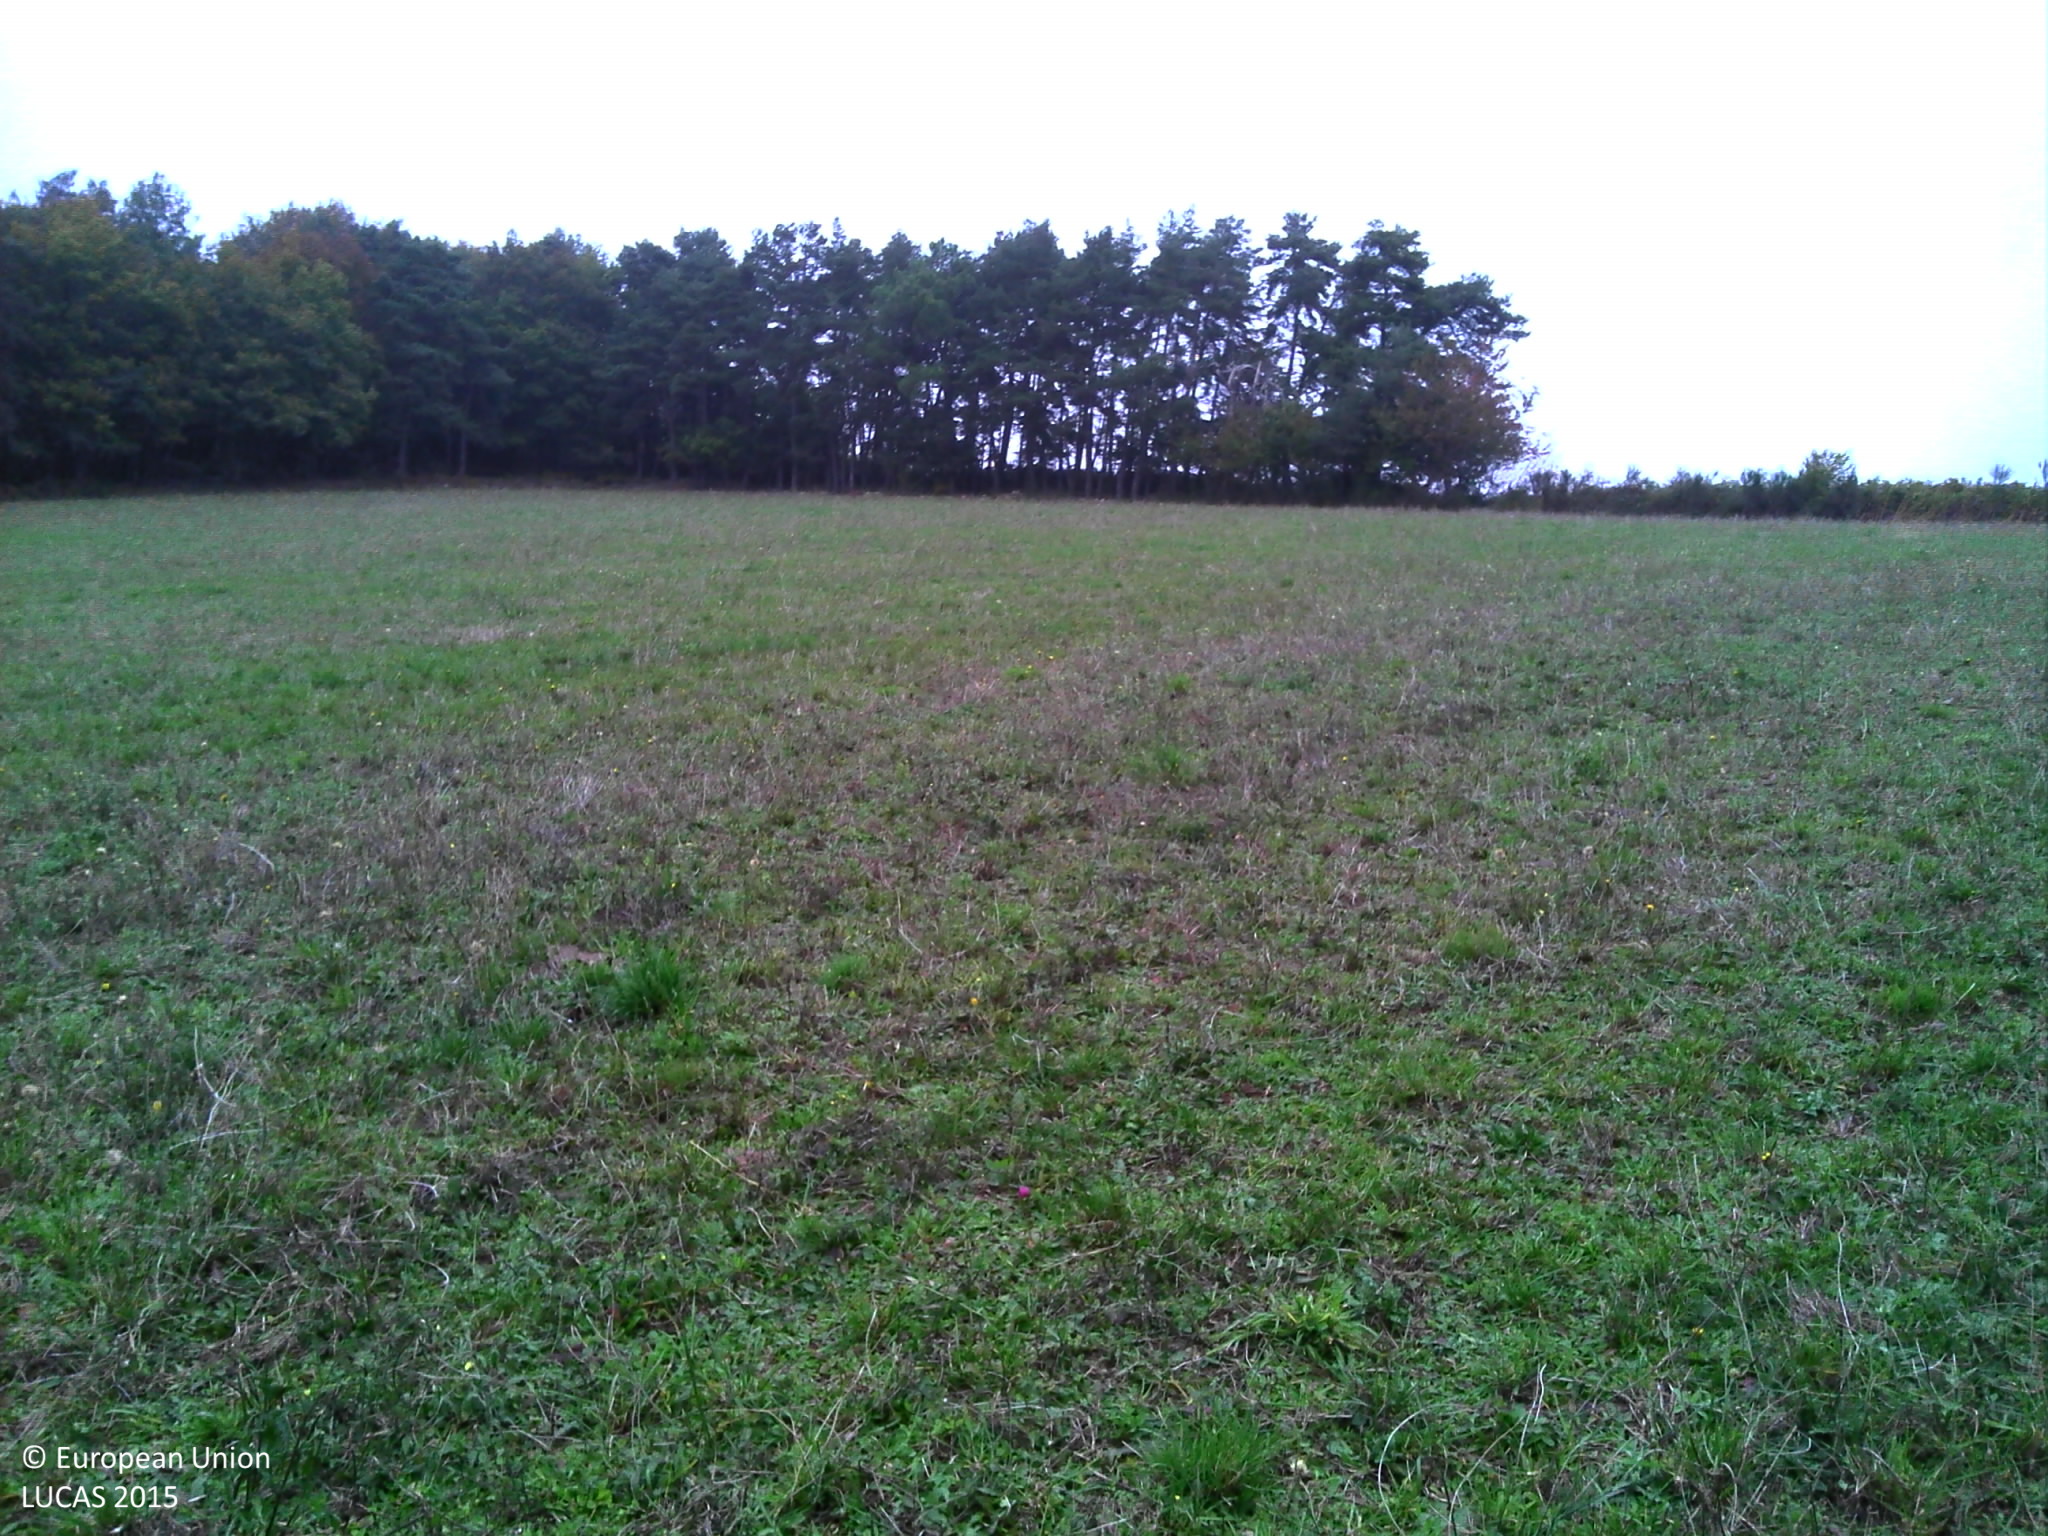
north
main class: Grassland
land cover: Grassland without tree/shrub cover
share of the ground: > 75 %
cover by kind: herbaceous plants 100 %
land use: Agriculture (excluding fallow land and kitchen gardens)
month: October
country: FR
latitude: 46.0516
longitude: 3.0324
